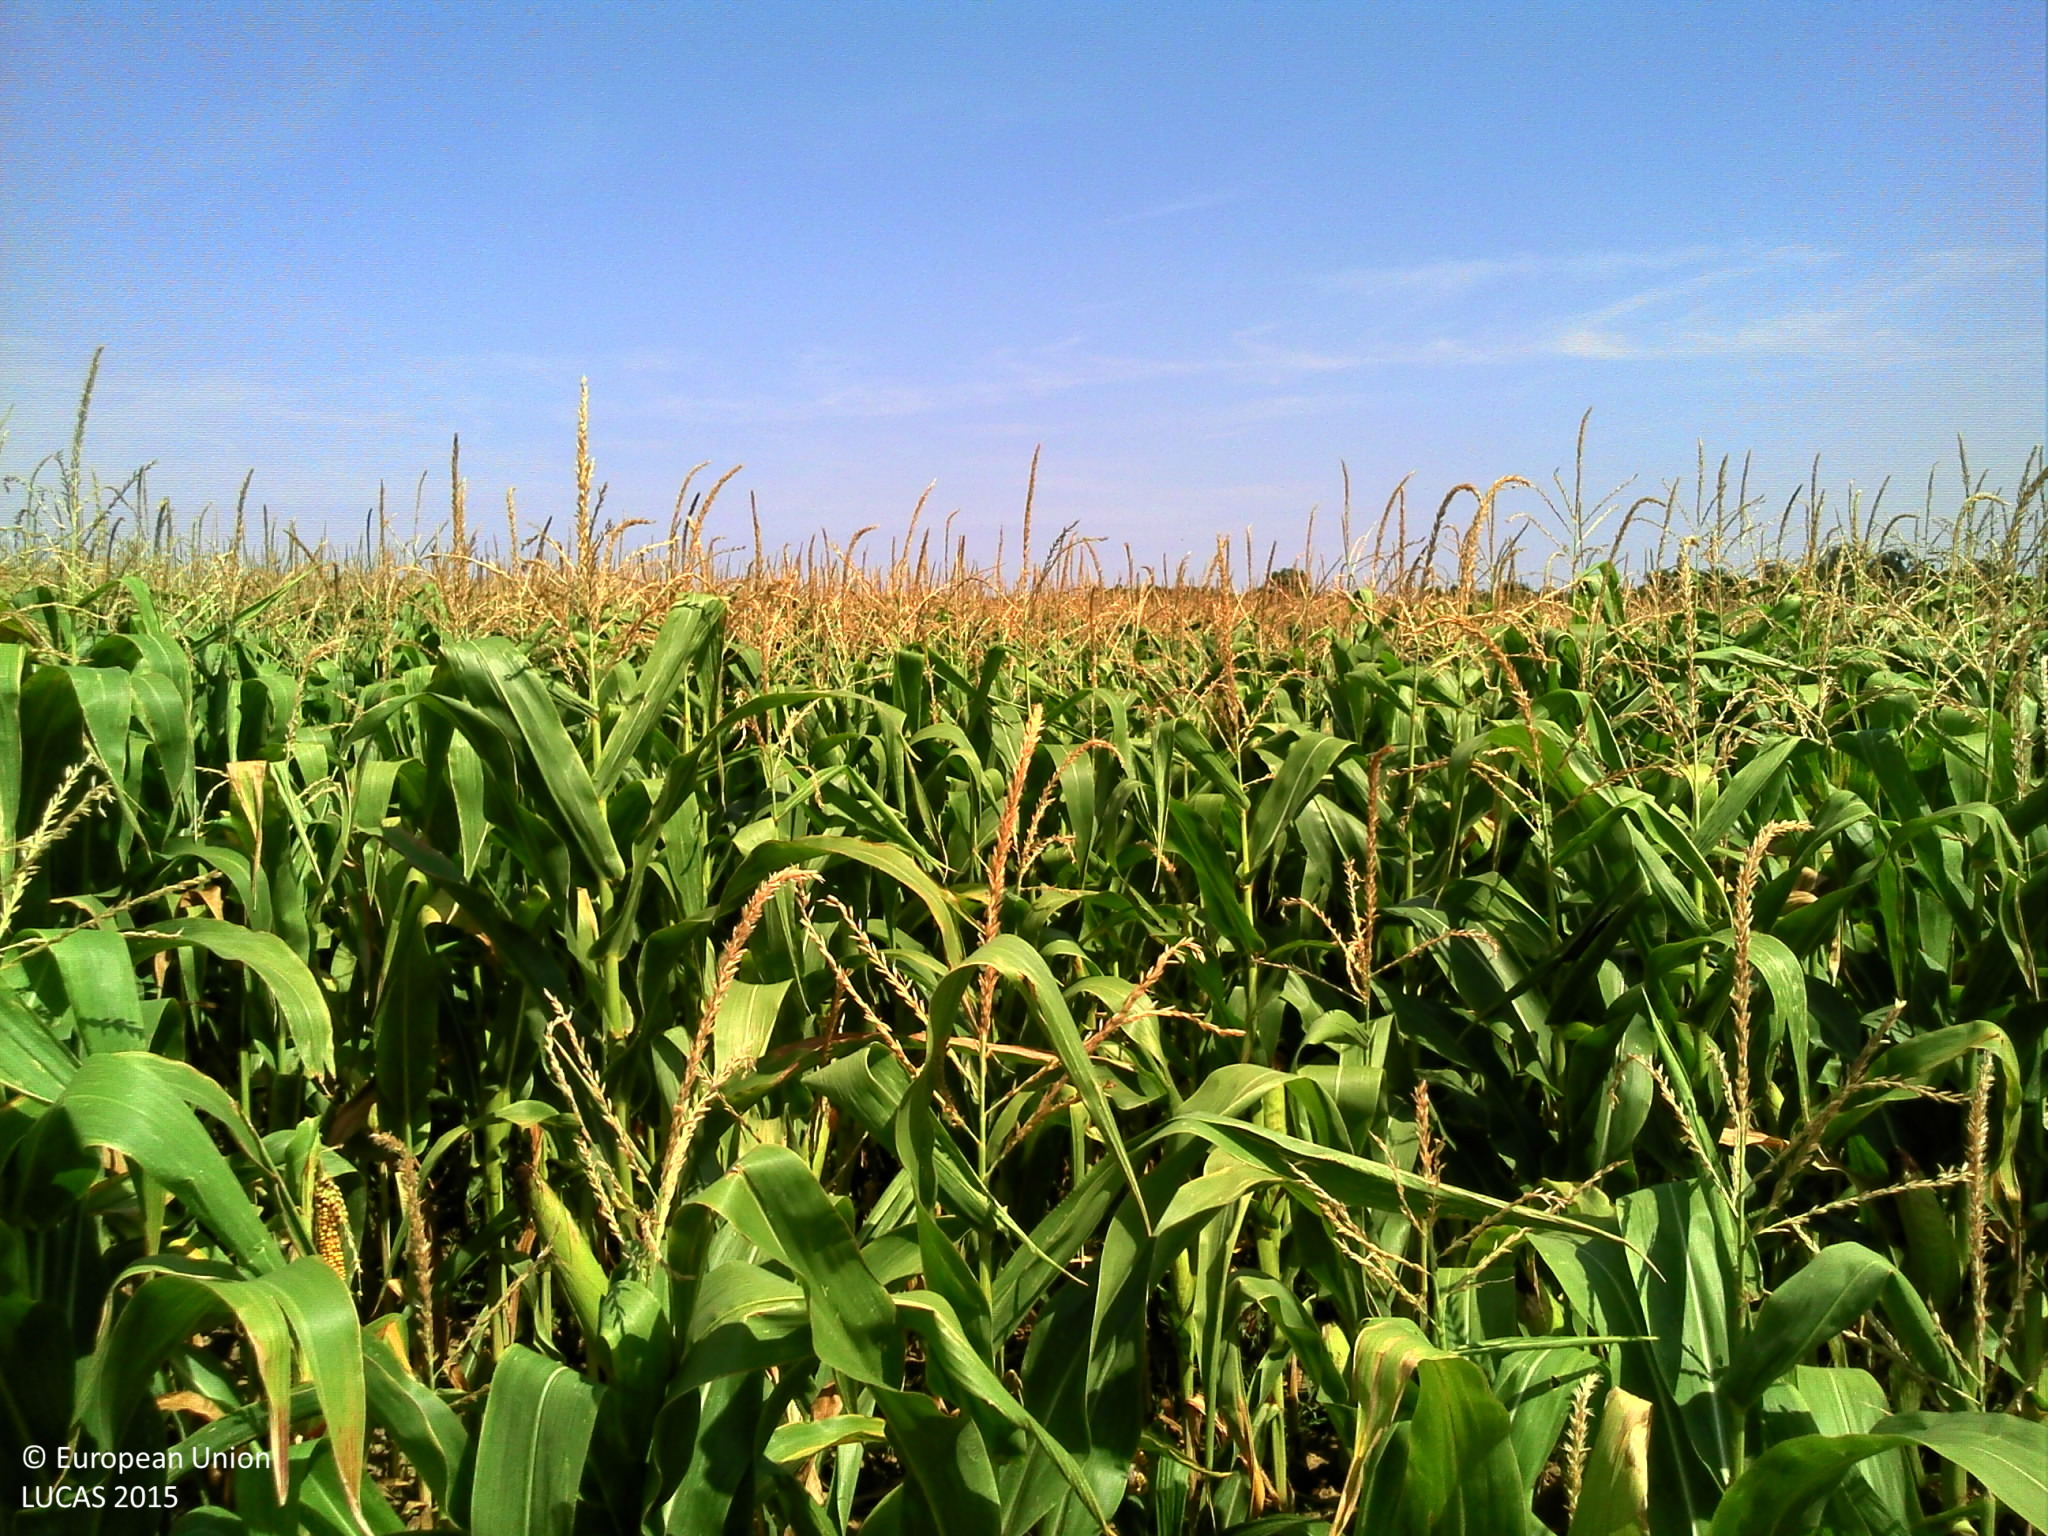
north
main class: Cropland
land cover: Maize
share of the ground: > 75 %
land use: Agriculture (excluding fallow land and kitchen gardens)
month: August
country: FR
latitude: 46.2176
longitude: 0.2985
